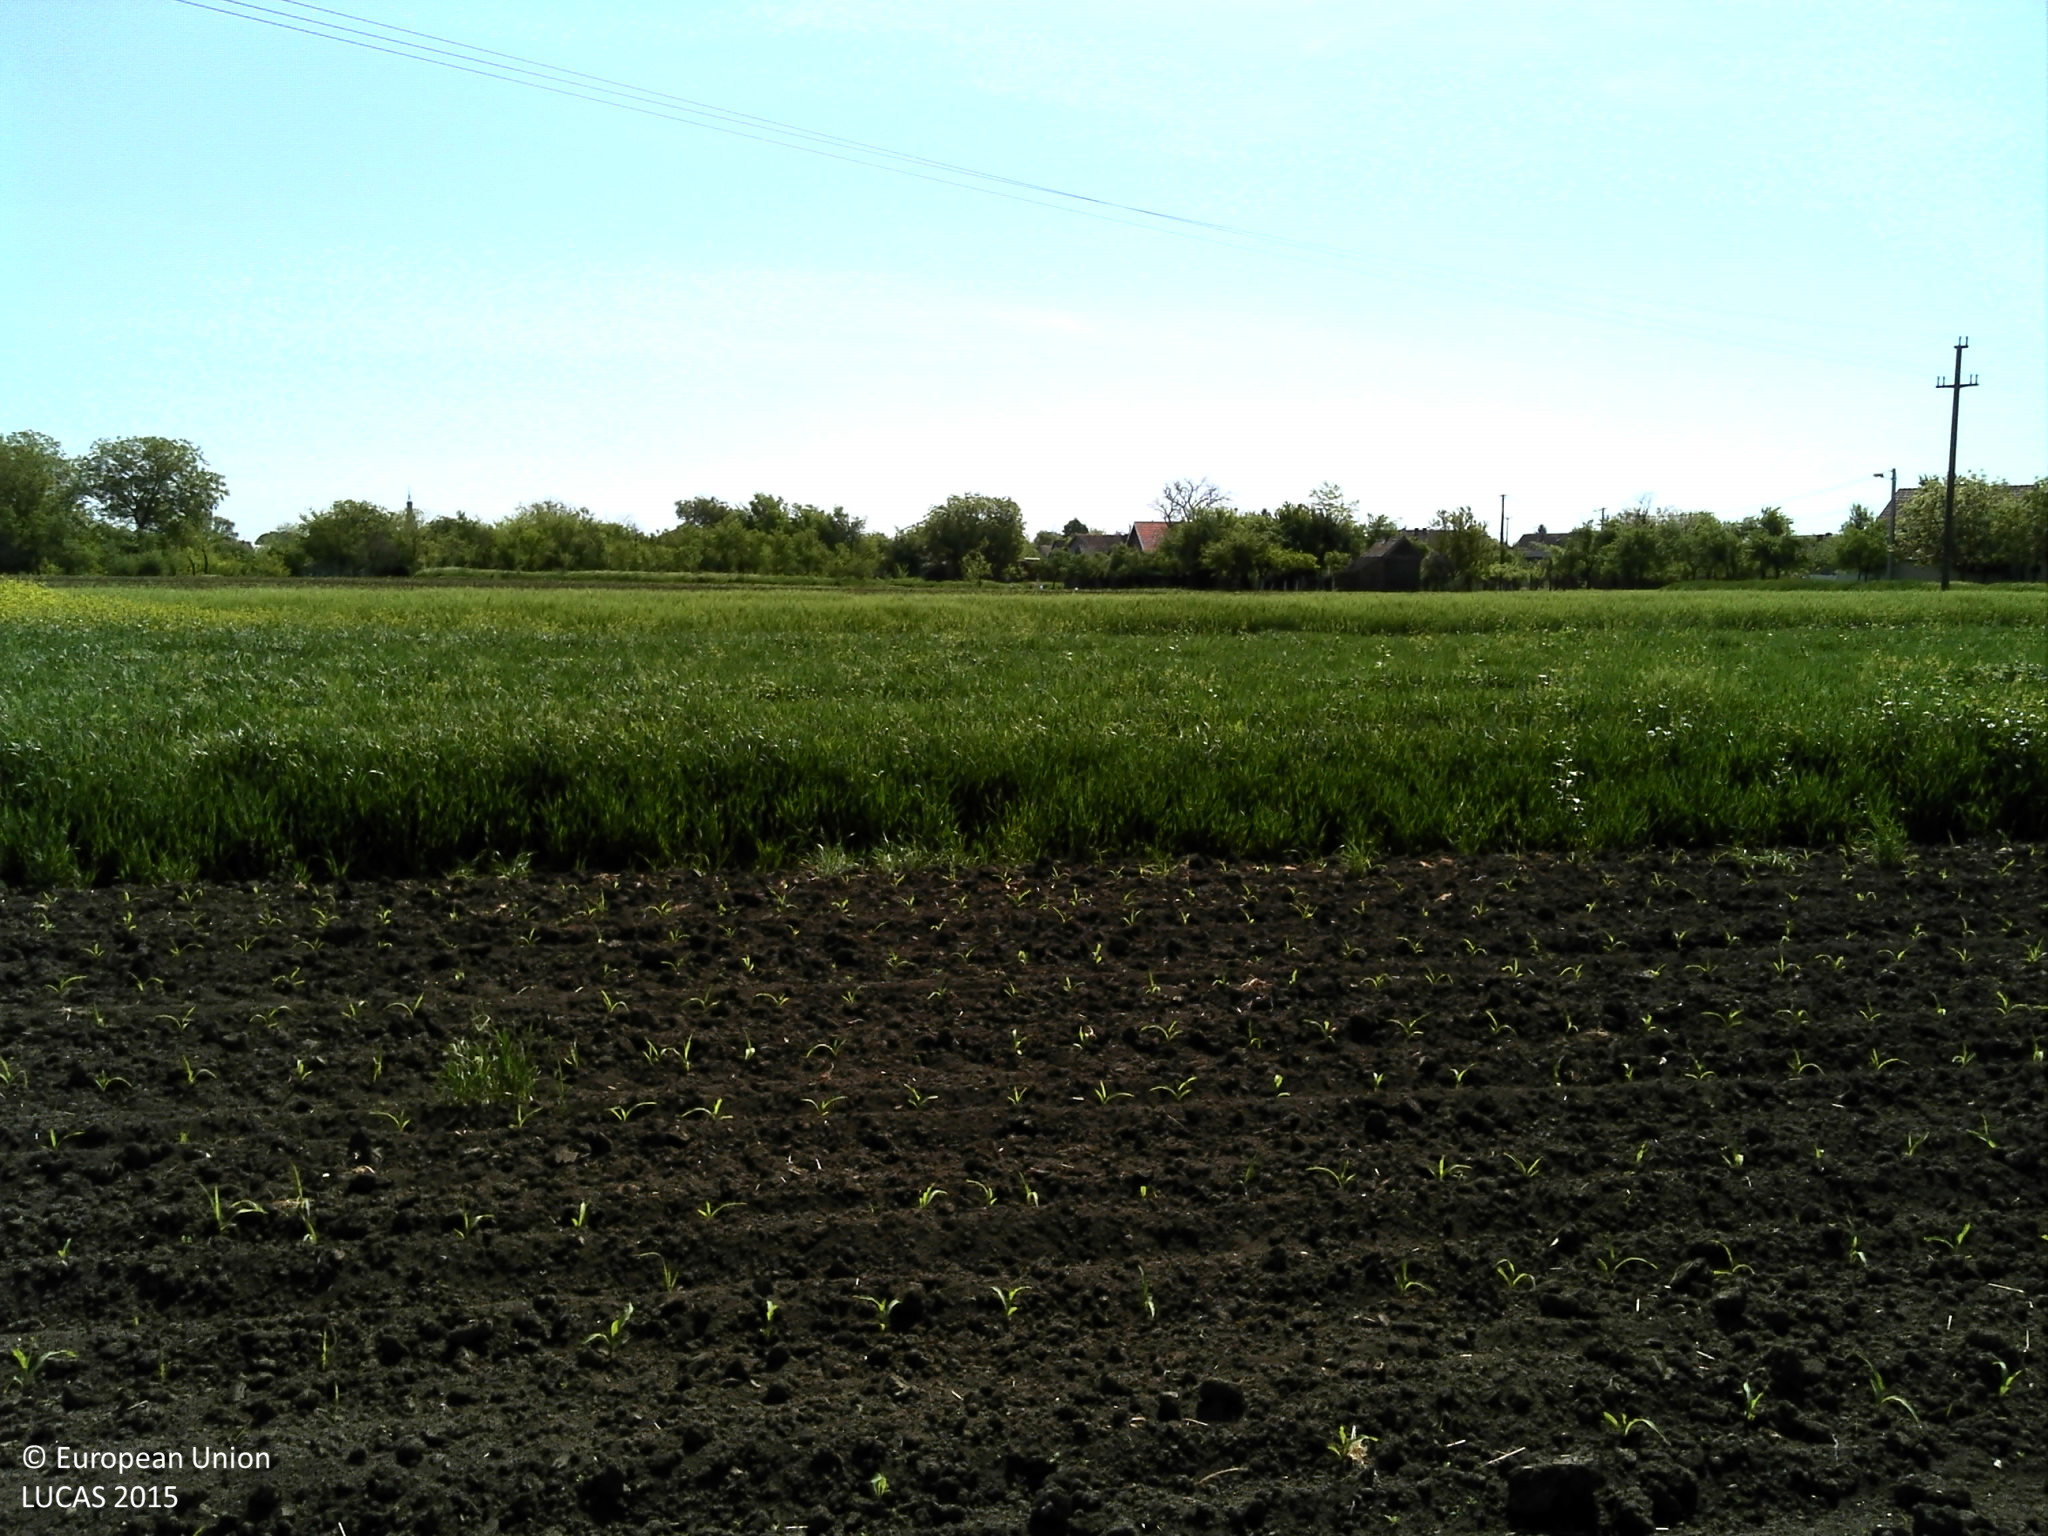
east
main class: Cropland
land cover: Maize
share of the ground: < 10 %
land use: Agriculture (excluding fallow land and kitchen gardens)
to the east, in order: Maize; Barley; Electric lines; Maize; Other fruit trees and berries; Ditches and canals; Tracks; Maize; Common wheat
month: May
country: HR
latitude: 45.4187
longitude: 18.8900
